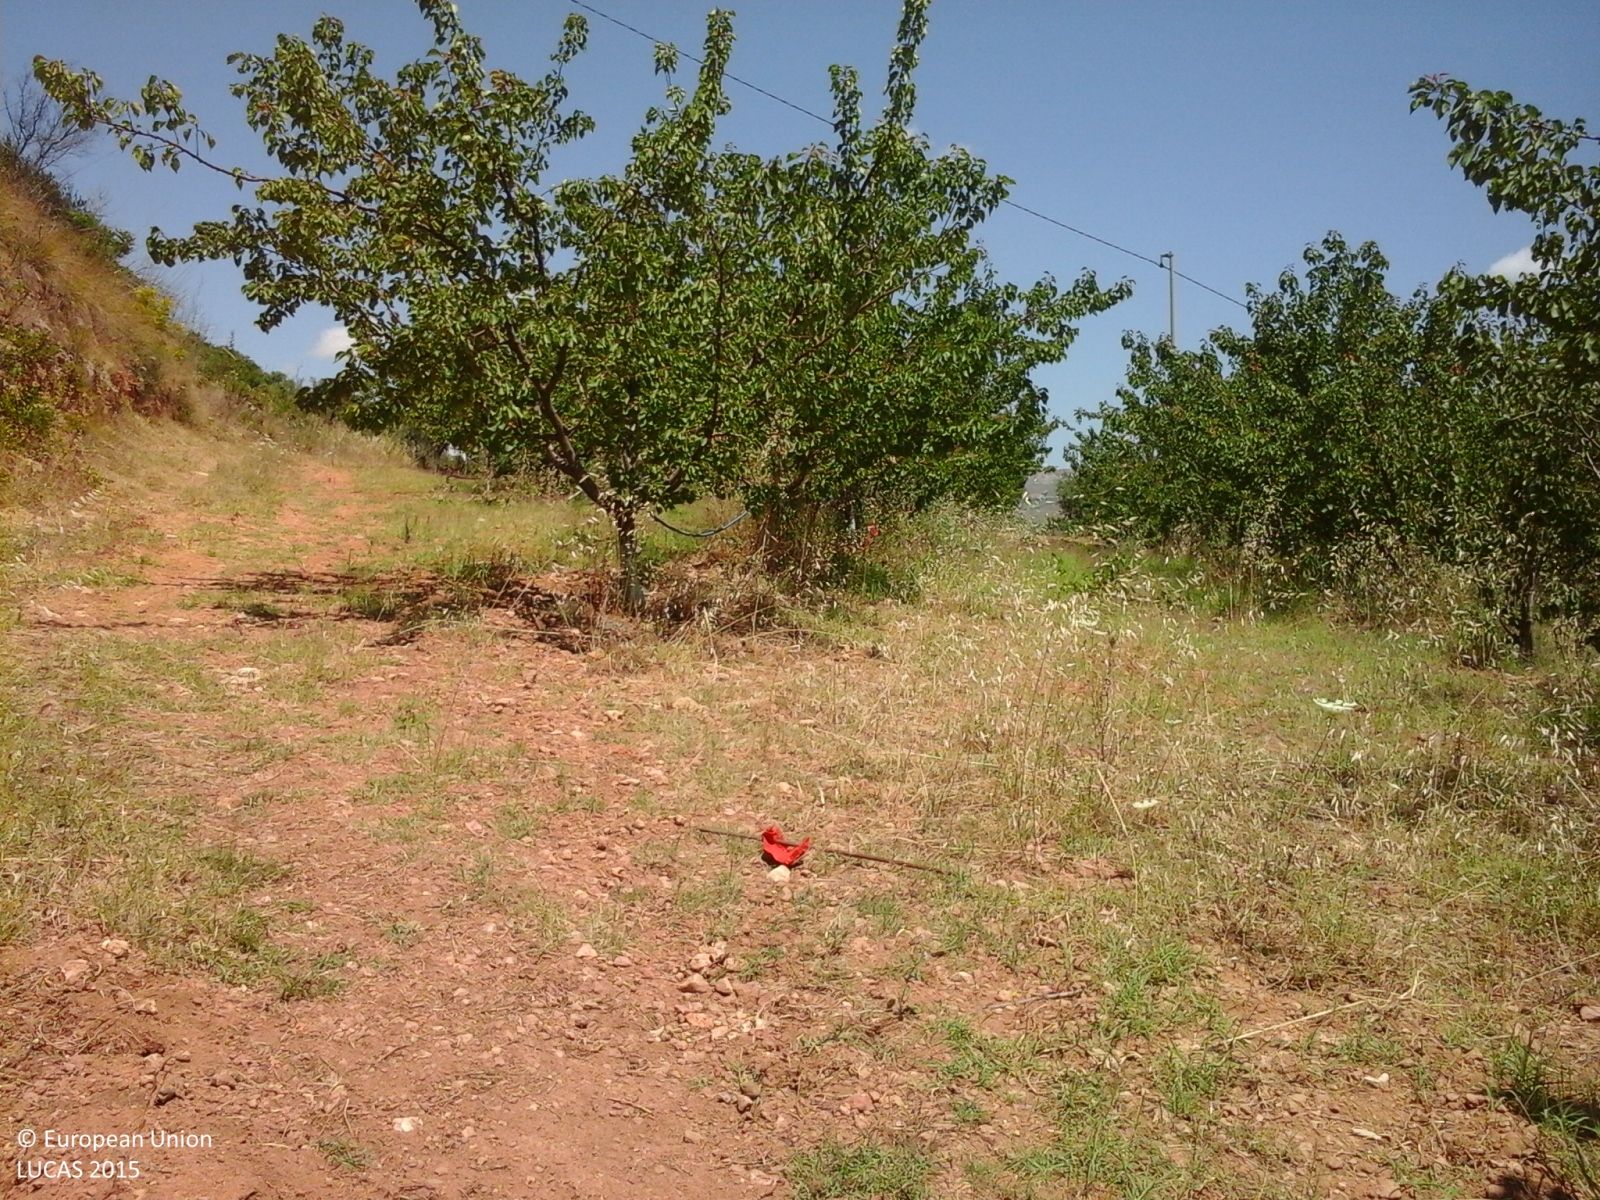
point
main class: Cropland
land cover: Other fruit trees and berries
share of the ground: 25 - 50 %
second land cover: Spontaneously vegetated surfaces
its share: 50 - 75 %
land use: Agriculture (excluding fallow land and kitchen gardens)
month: June
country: IT
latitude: 37.7385
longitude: 12.9398
